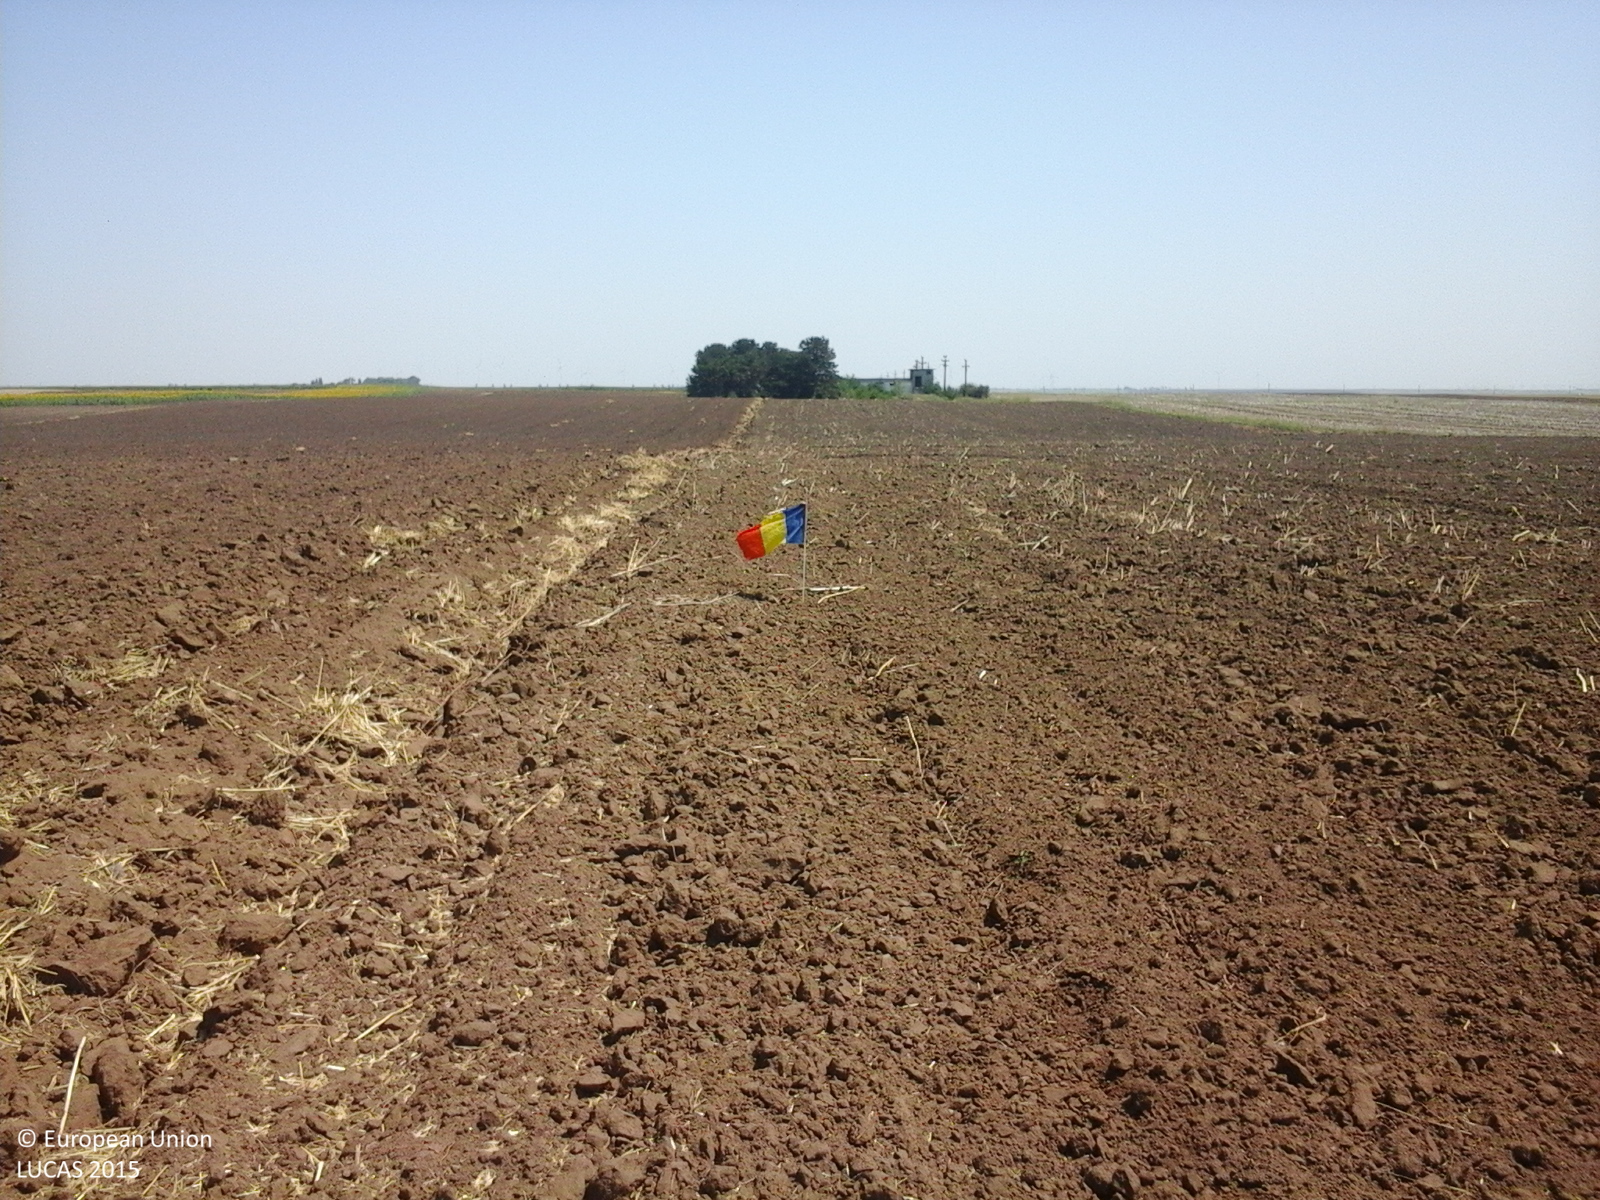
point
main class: Cropland
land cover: Rape and turnip rape
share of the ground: < 10 %
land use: Agriculture (excluding fallow land and kitchen gardens)
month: July
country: RO
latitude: 44.5446
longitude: 27.6040
